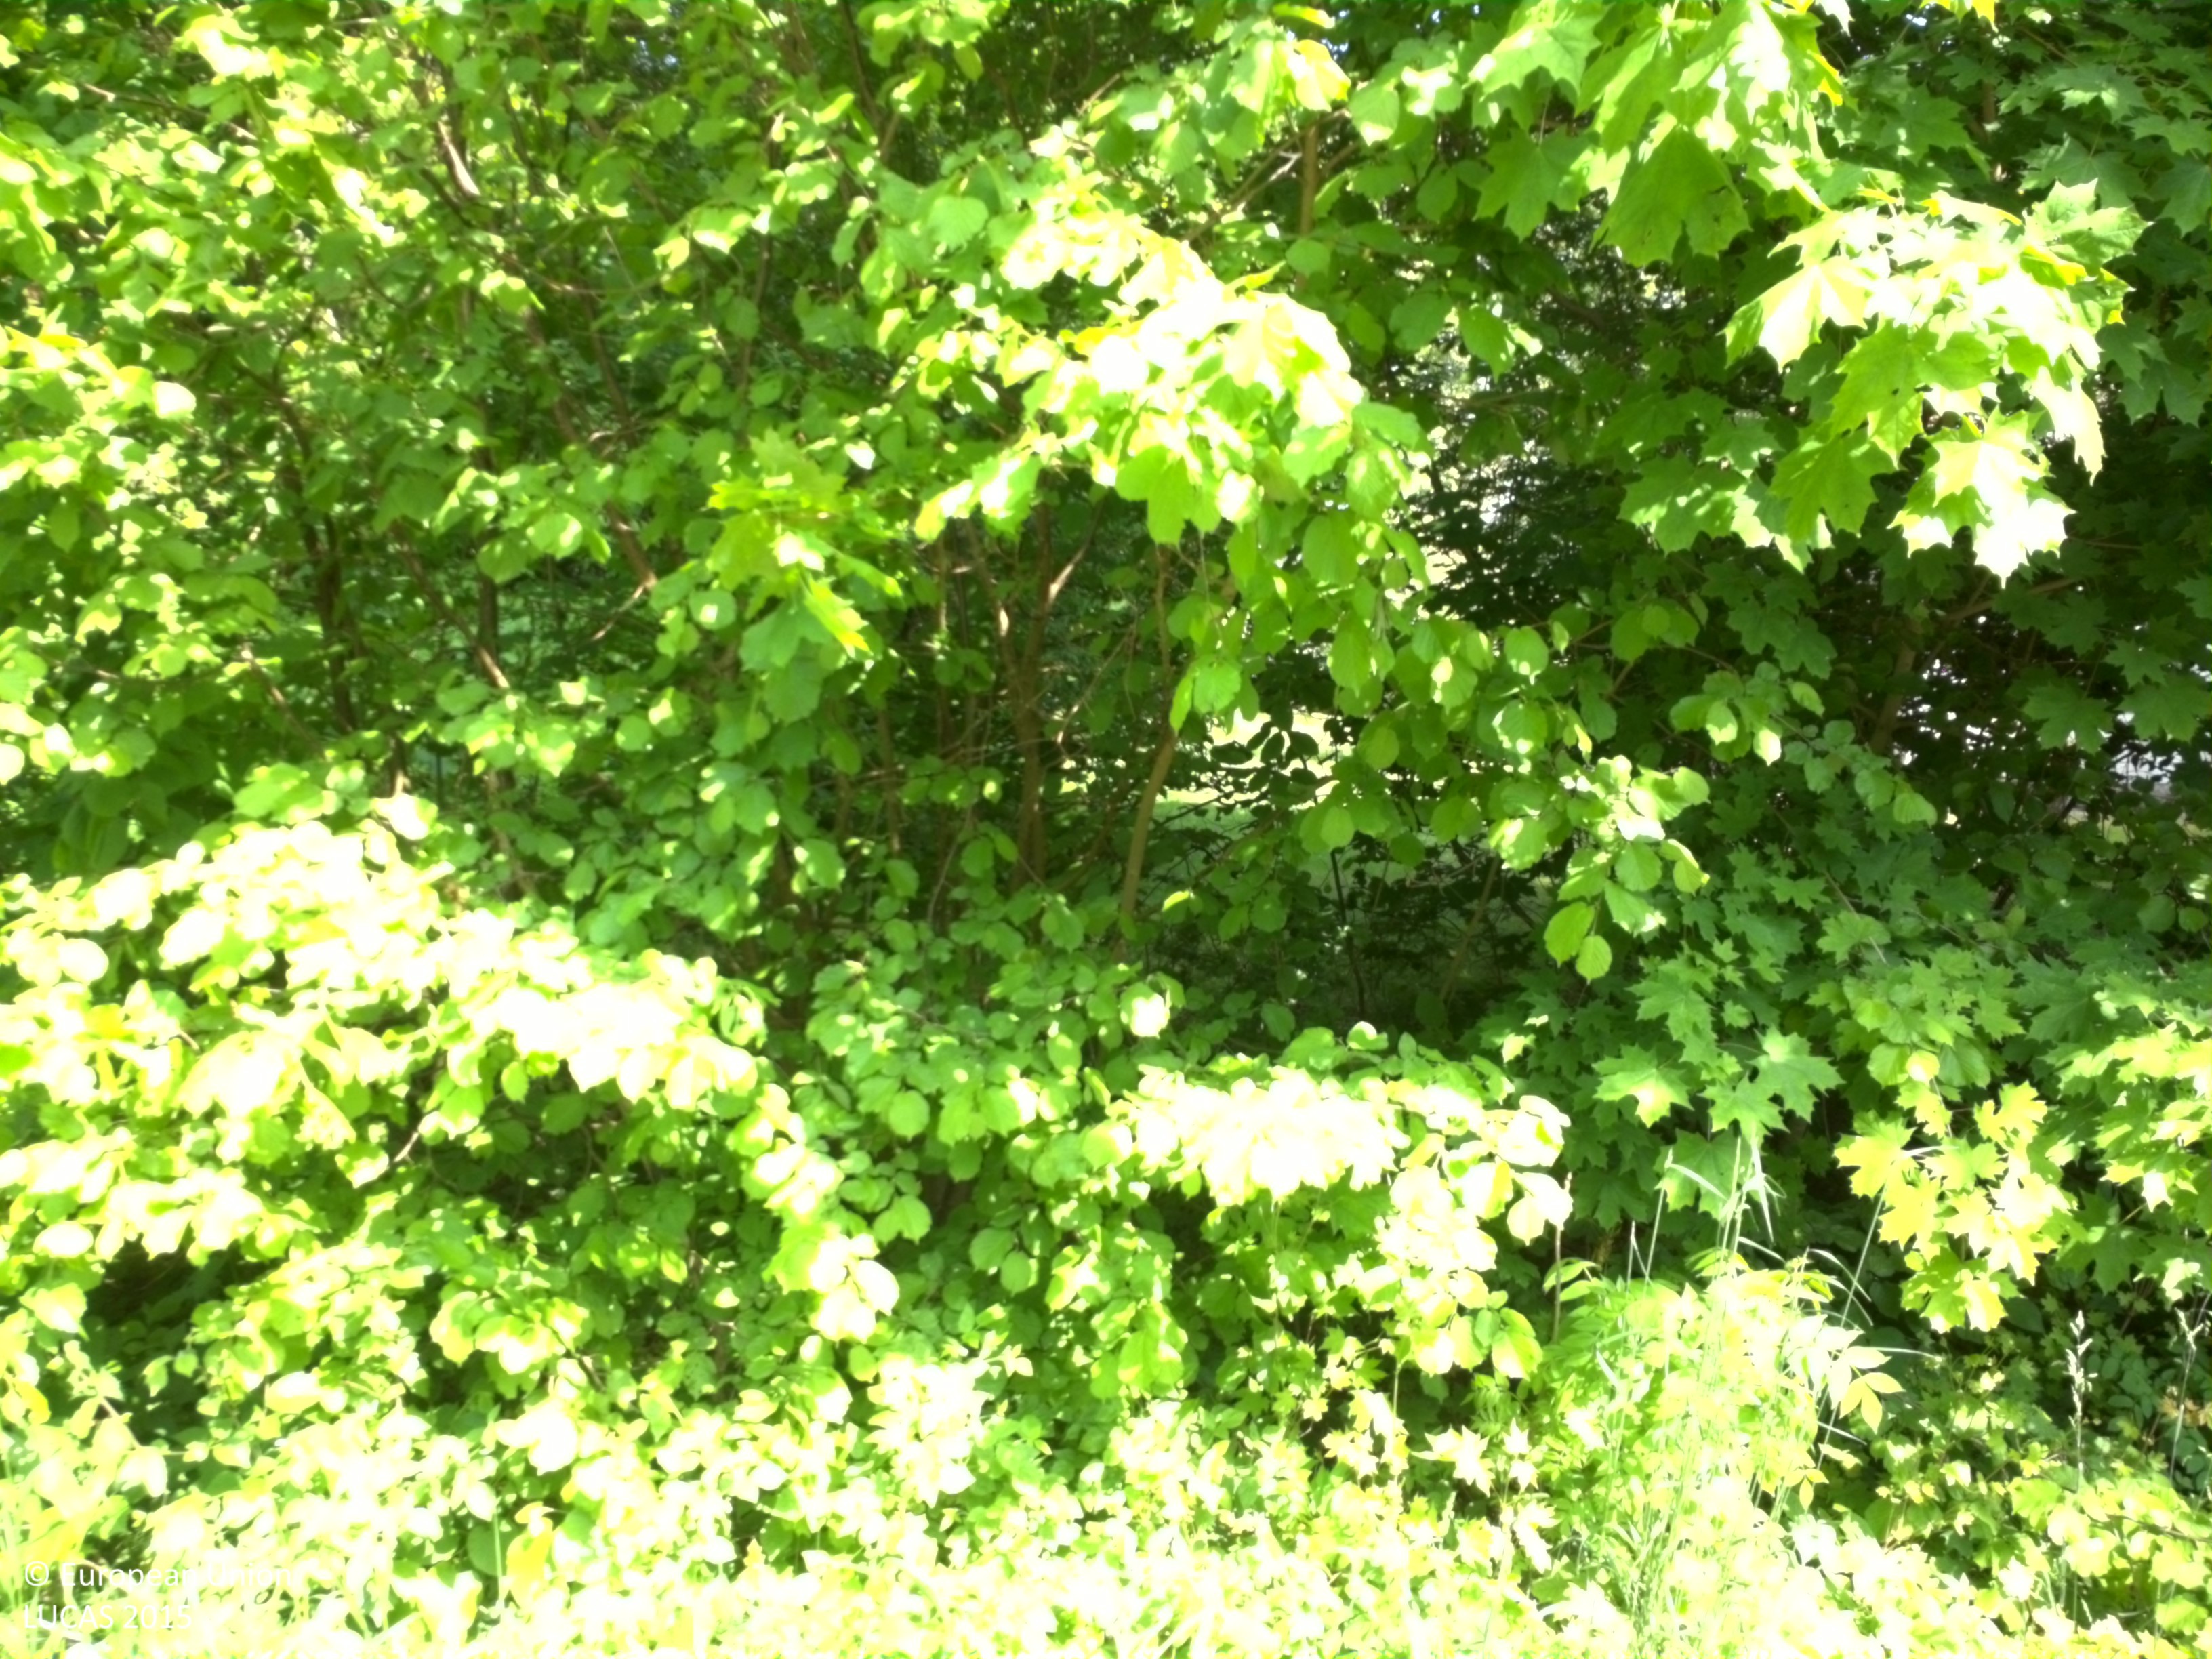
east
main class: Woodland
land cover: Broadleaved woodland
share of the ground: > 75 %
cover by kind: broadleaved forest trees 90 %, herbaceous plants 10 %
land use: Residential
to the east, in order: Broadleaved woodland; Grassland with sparse tree/shrub cover; Groves; Barley
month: June
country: SE
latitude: 58.4871
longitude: 15.4659
